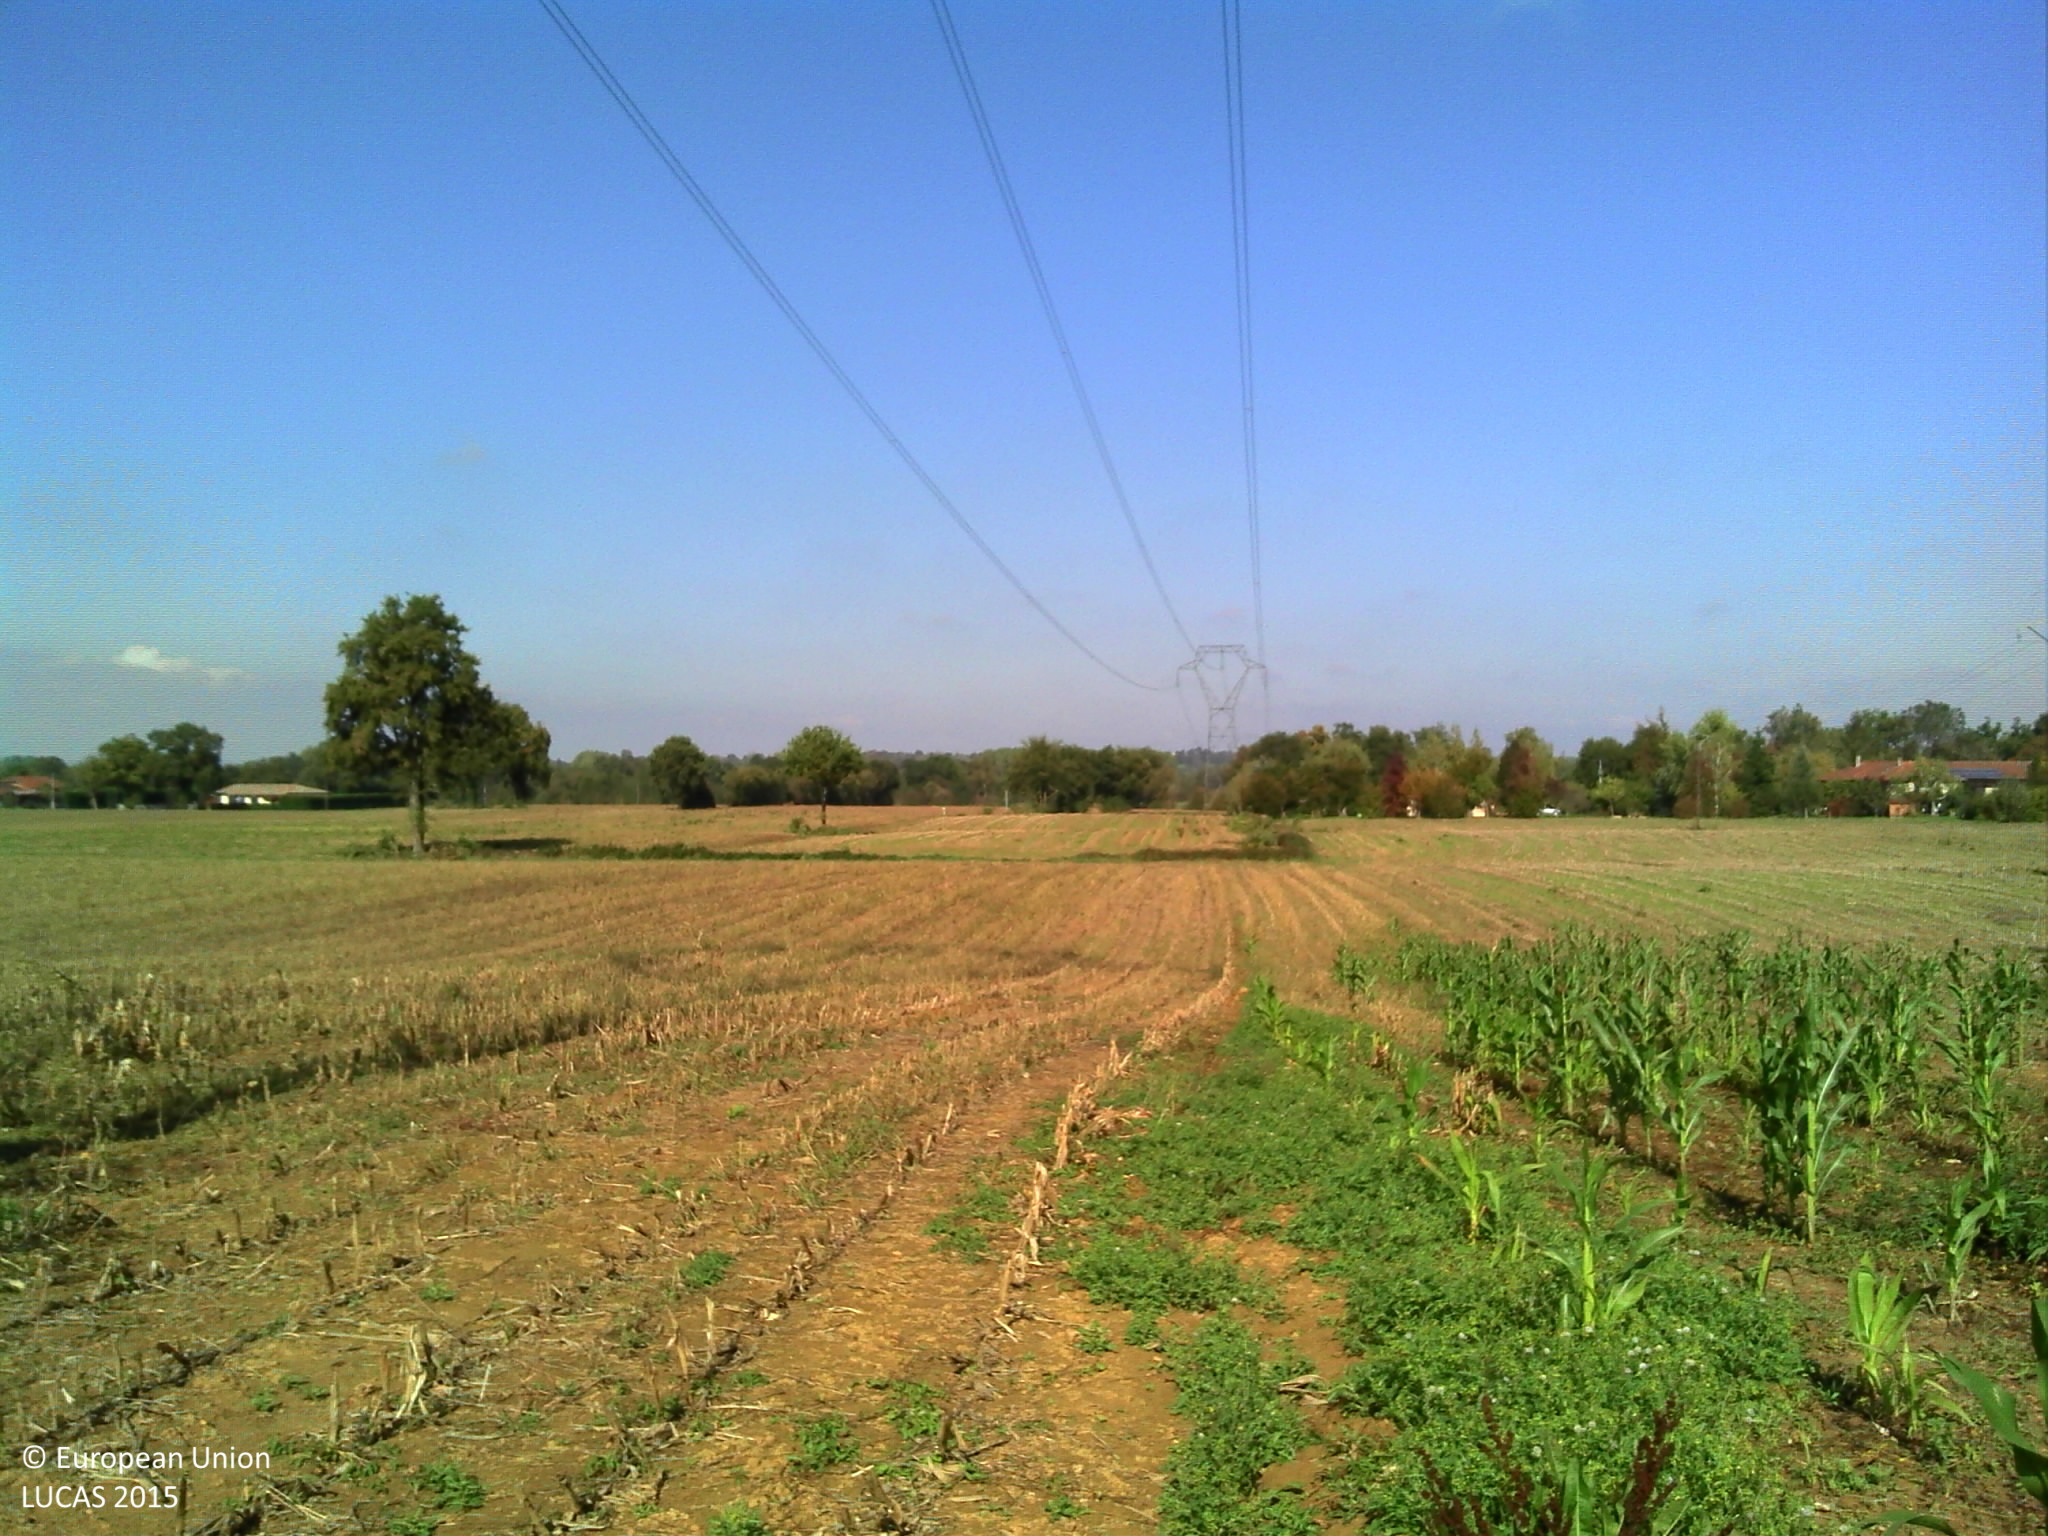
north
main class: Cropland
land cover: Maize
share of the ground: < 10 %
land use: Agriculture (excluding fallow land and kitchen gardens)
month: October
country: FR
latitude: 46.2479
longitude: 4.9051
